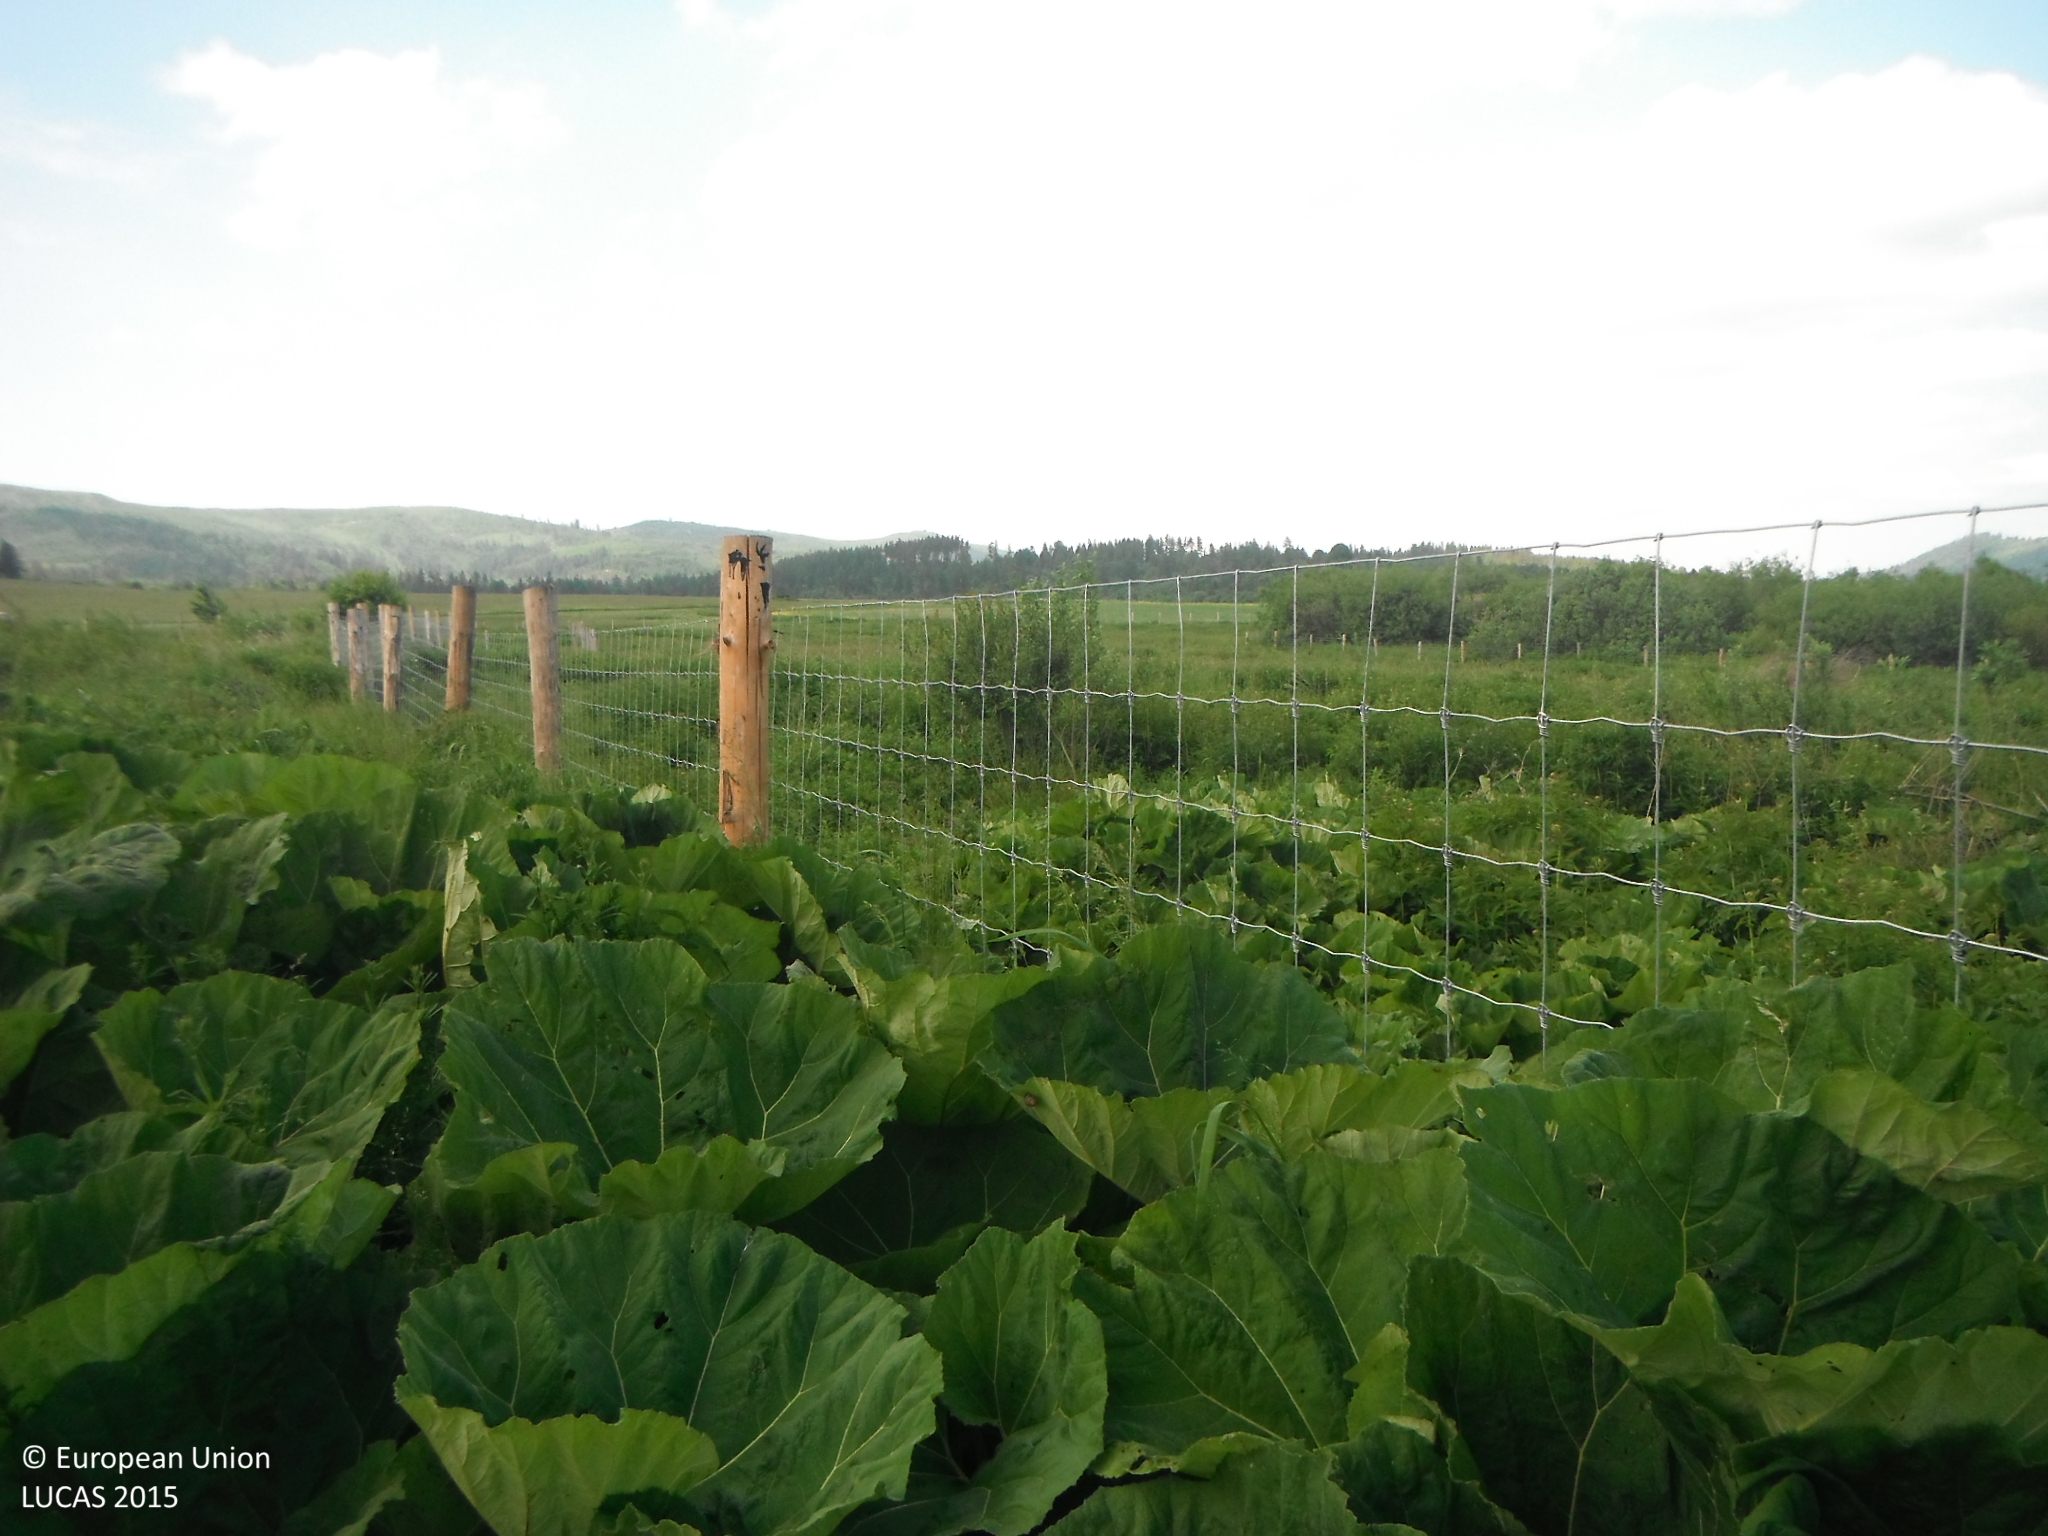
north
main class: Grassland
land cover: Spontaneously vegetated surfaces
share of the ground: > 75 %
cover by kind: herbaceous plants 100 %
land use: Fallow land
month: June
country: SK
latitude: 49.2354
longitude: 20.4045
